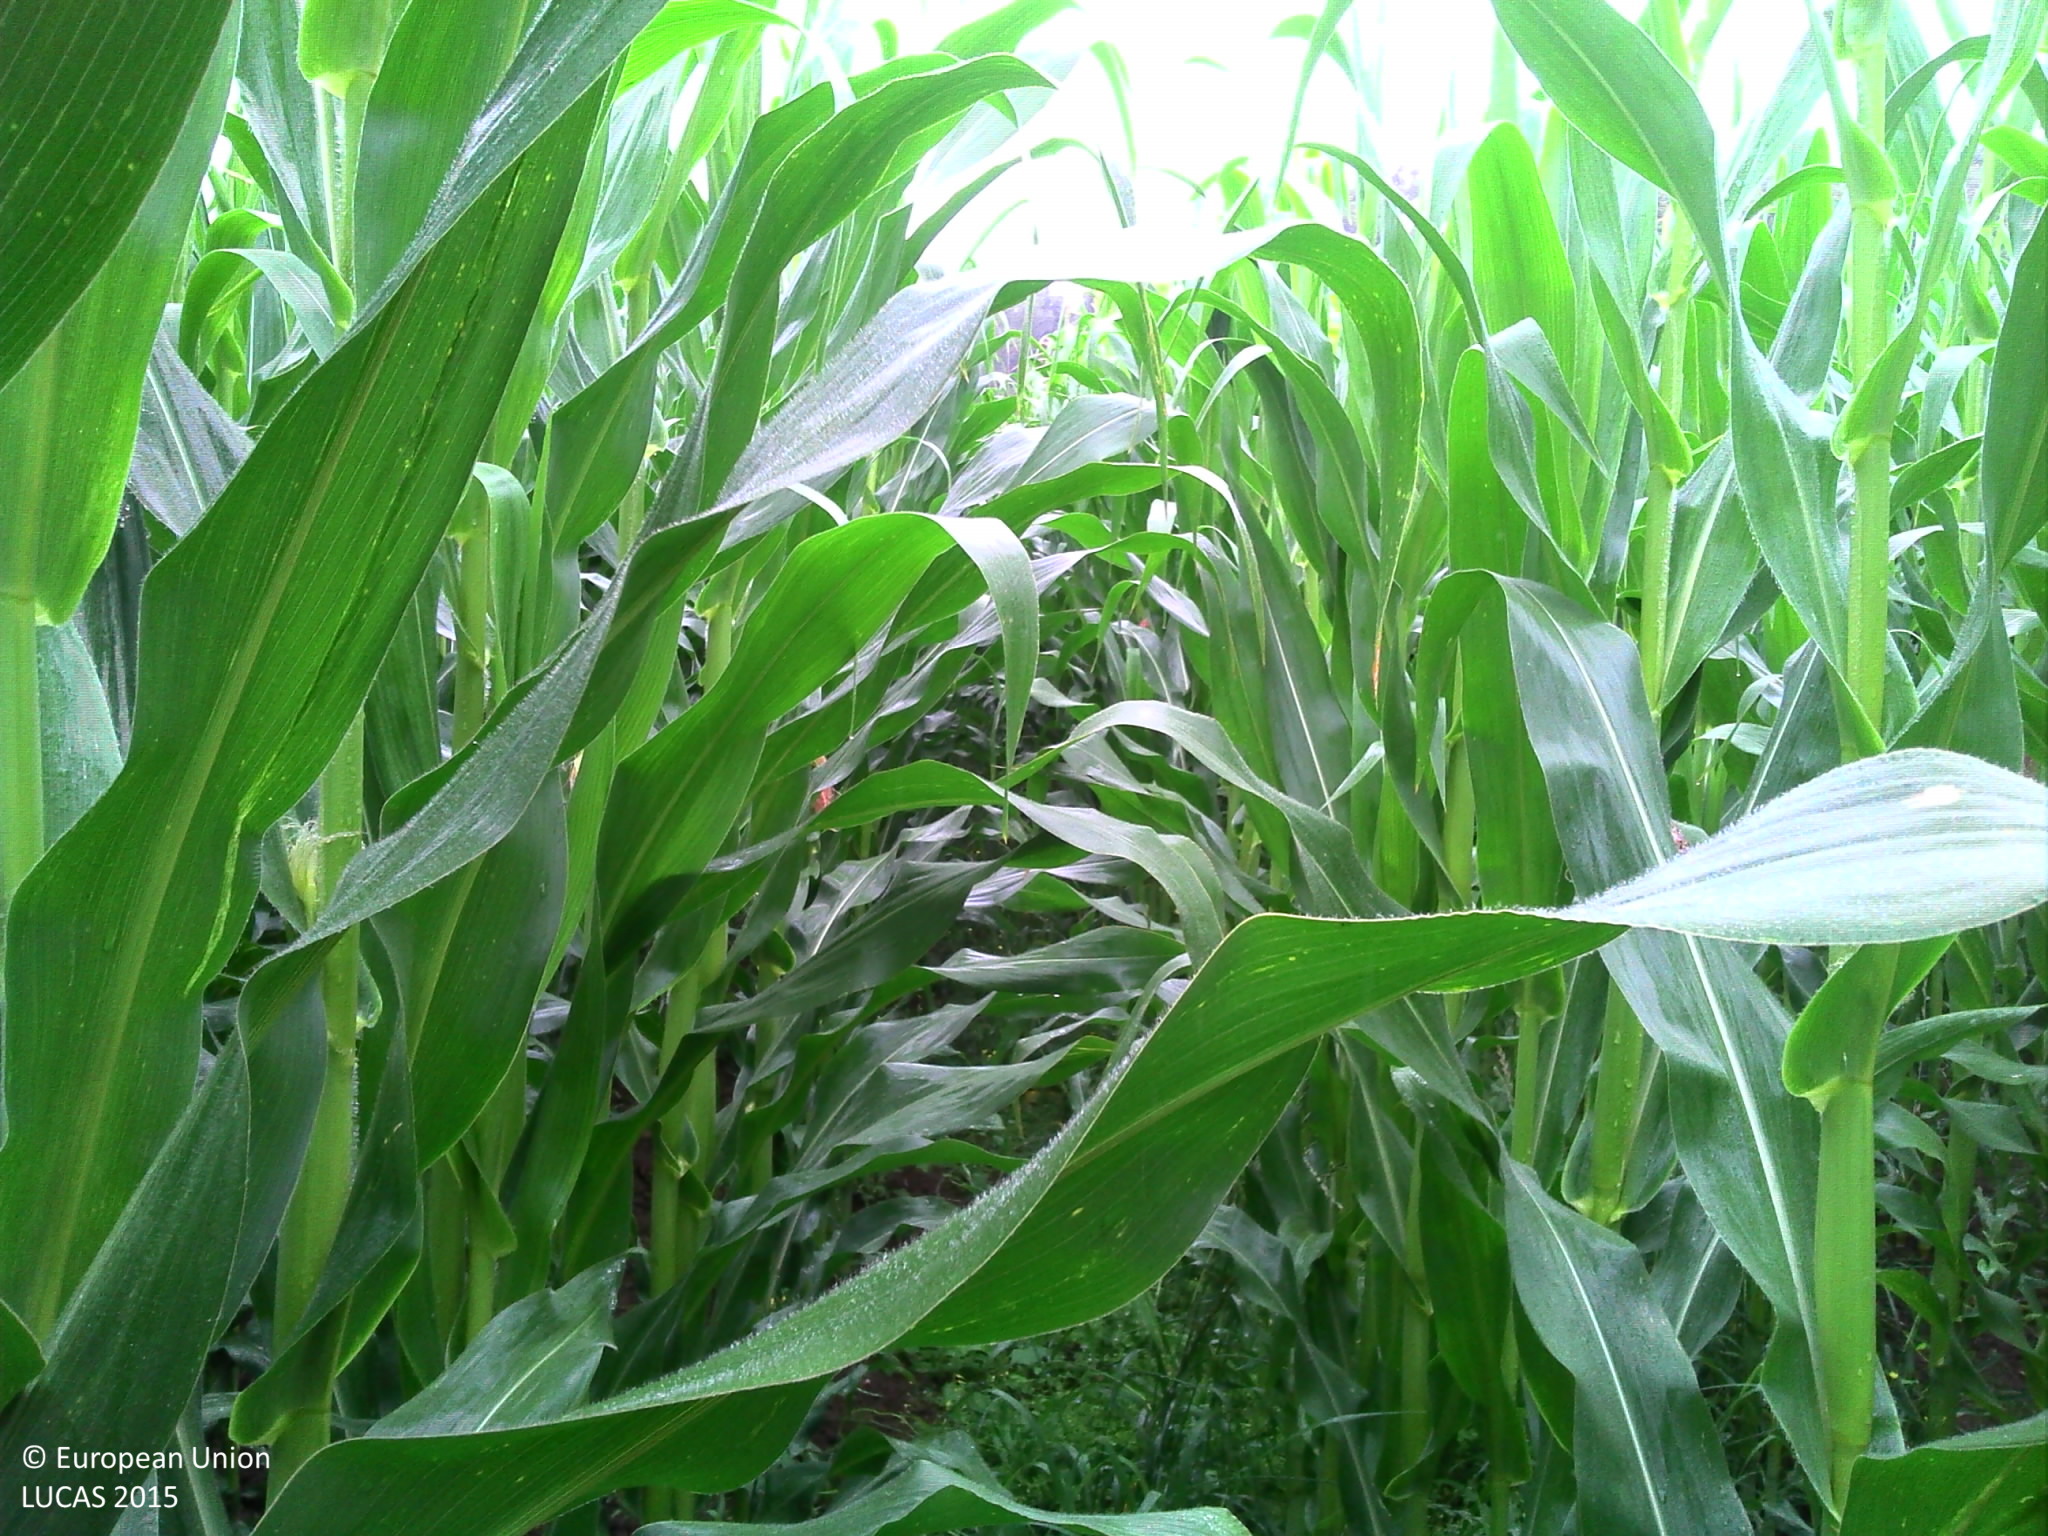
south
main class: Cropland
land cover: Maize
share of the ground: > 75 %
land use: Agriculture (excluding fallow land and kitchen gardens)
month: July
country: FR
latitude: 47.7635
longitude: -2.9676
